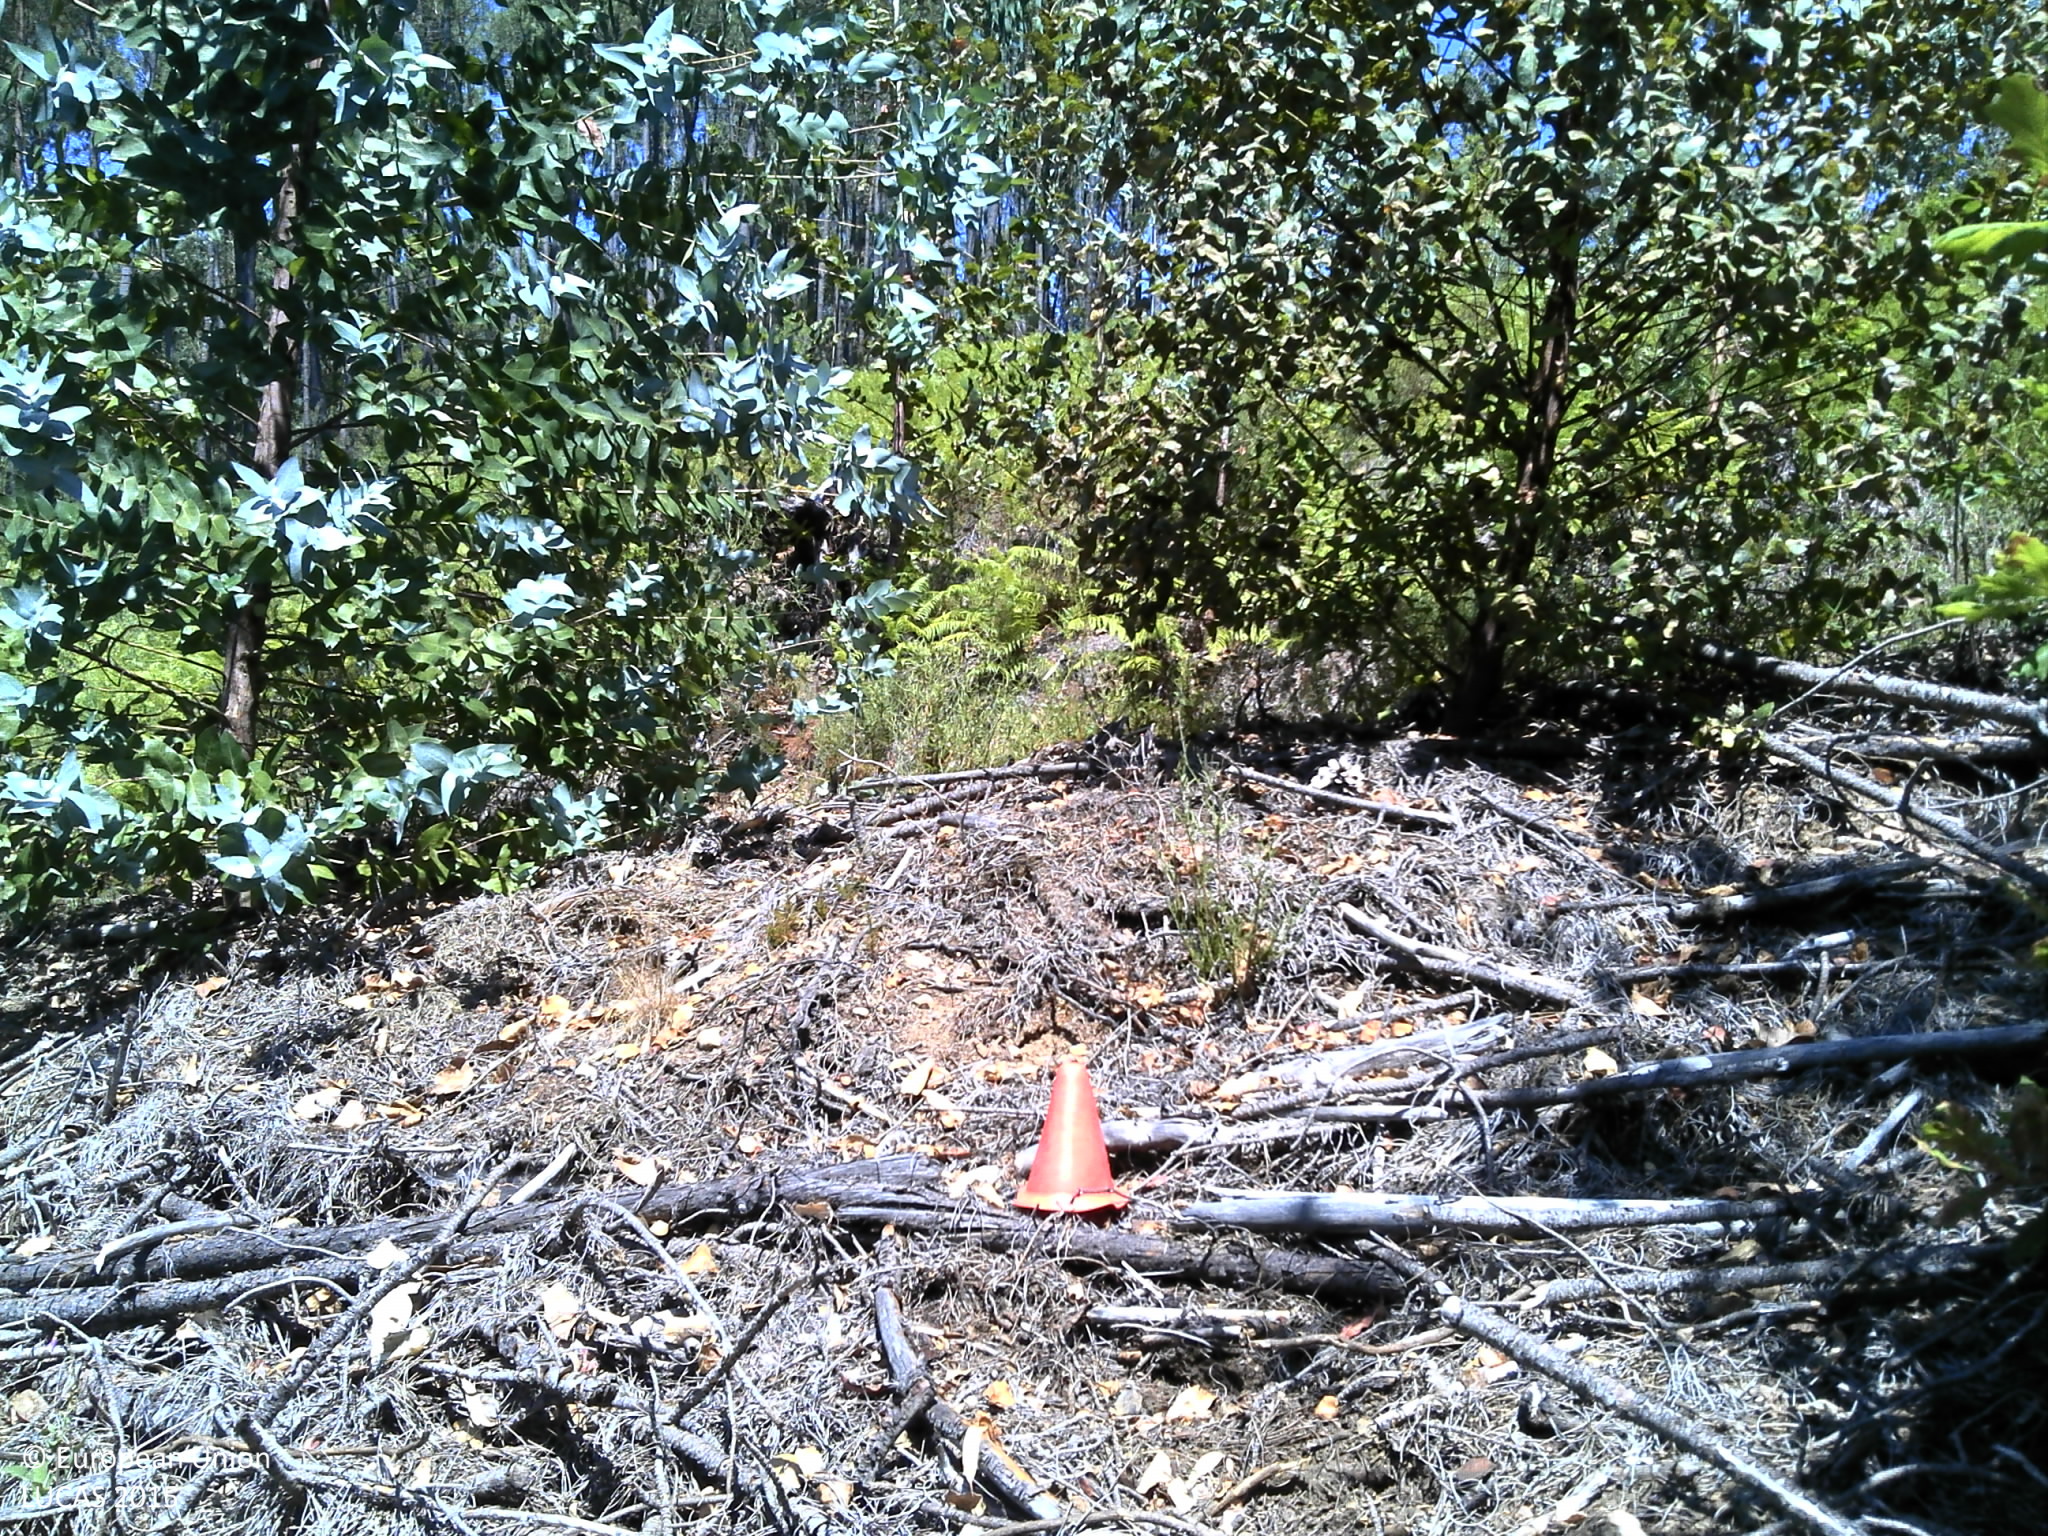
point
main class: Woodland
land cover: Broadleaved woodland
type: exotic forest
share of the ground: 10 - 25 %
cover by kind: unconsolidated bare surface 55 %, shrubs 30 %, broadleaved forest trees 15 %
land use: Forestry
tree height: > 5 m
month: July
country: PT
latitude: 39.9223
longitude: -8.1713
